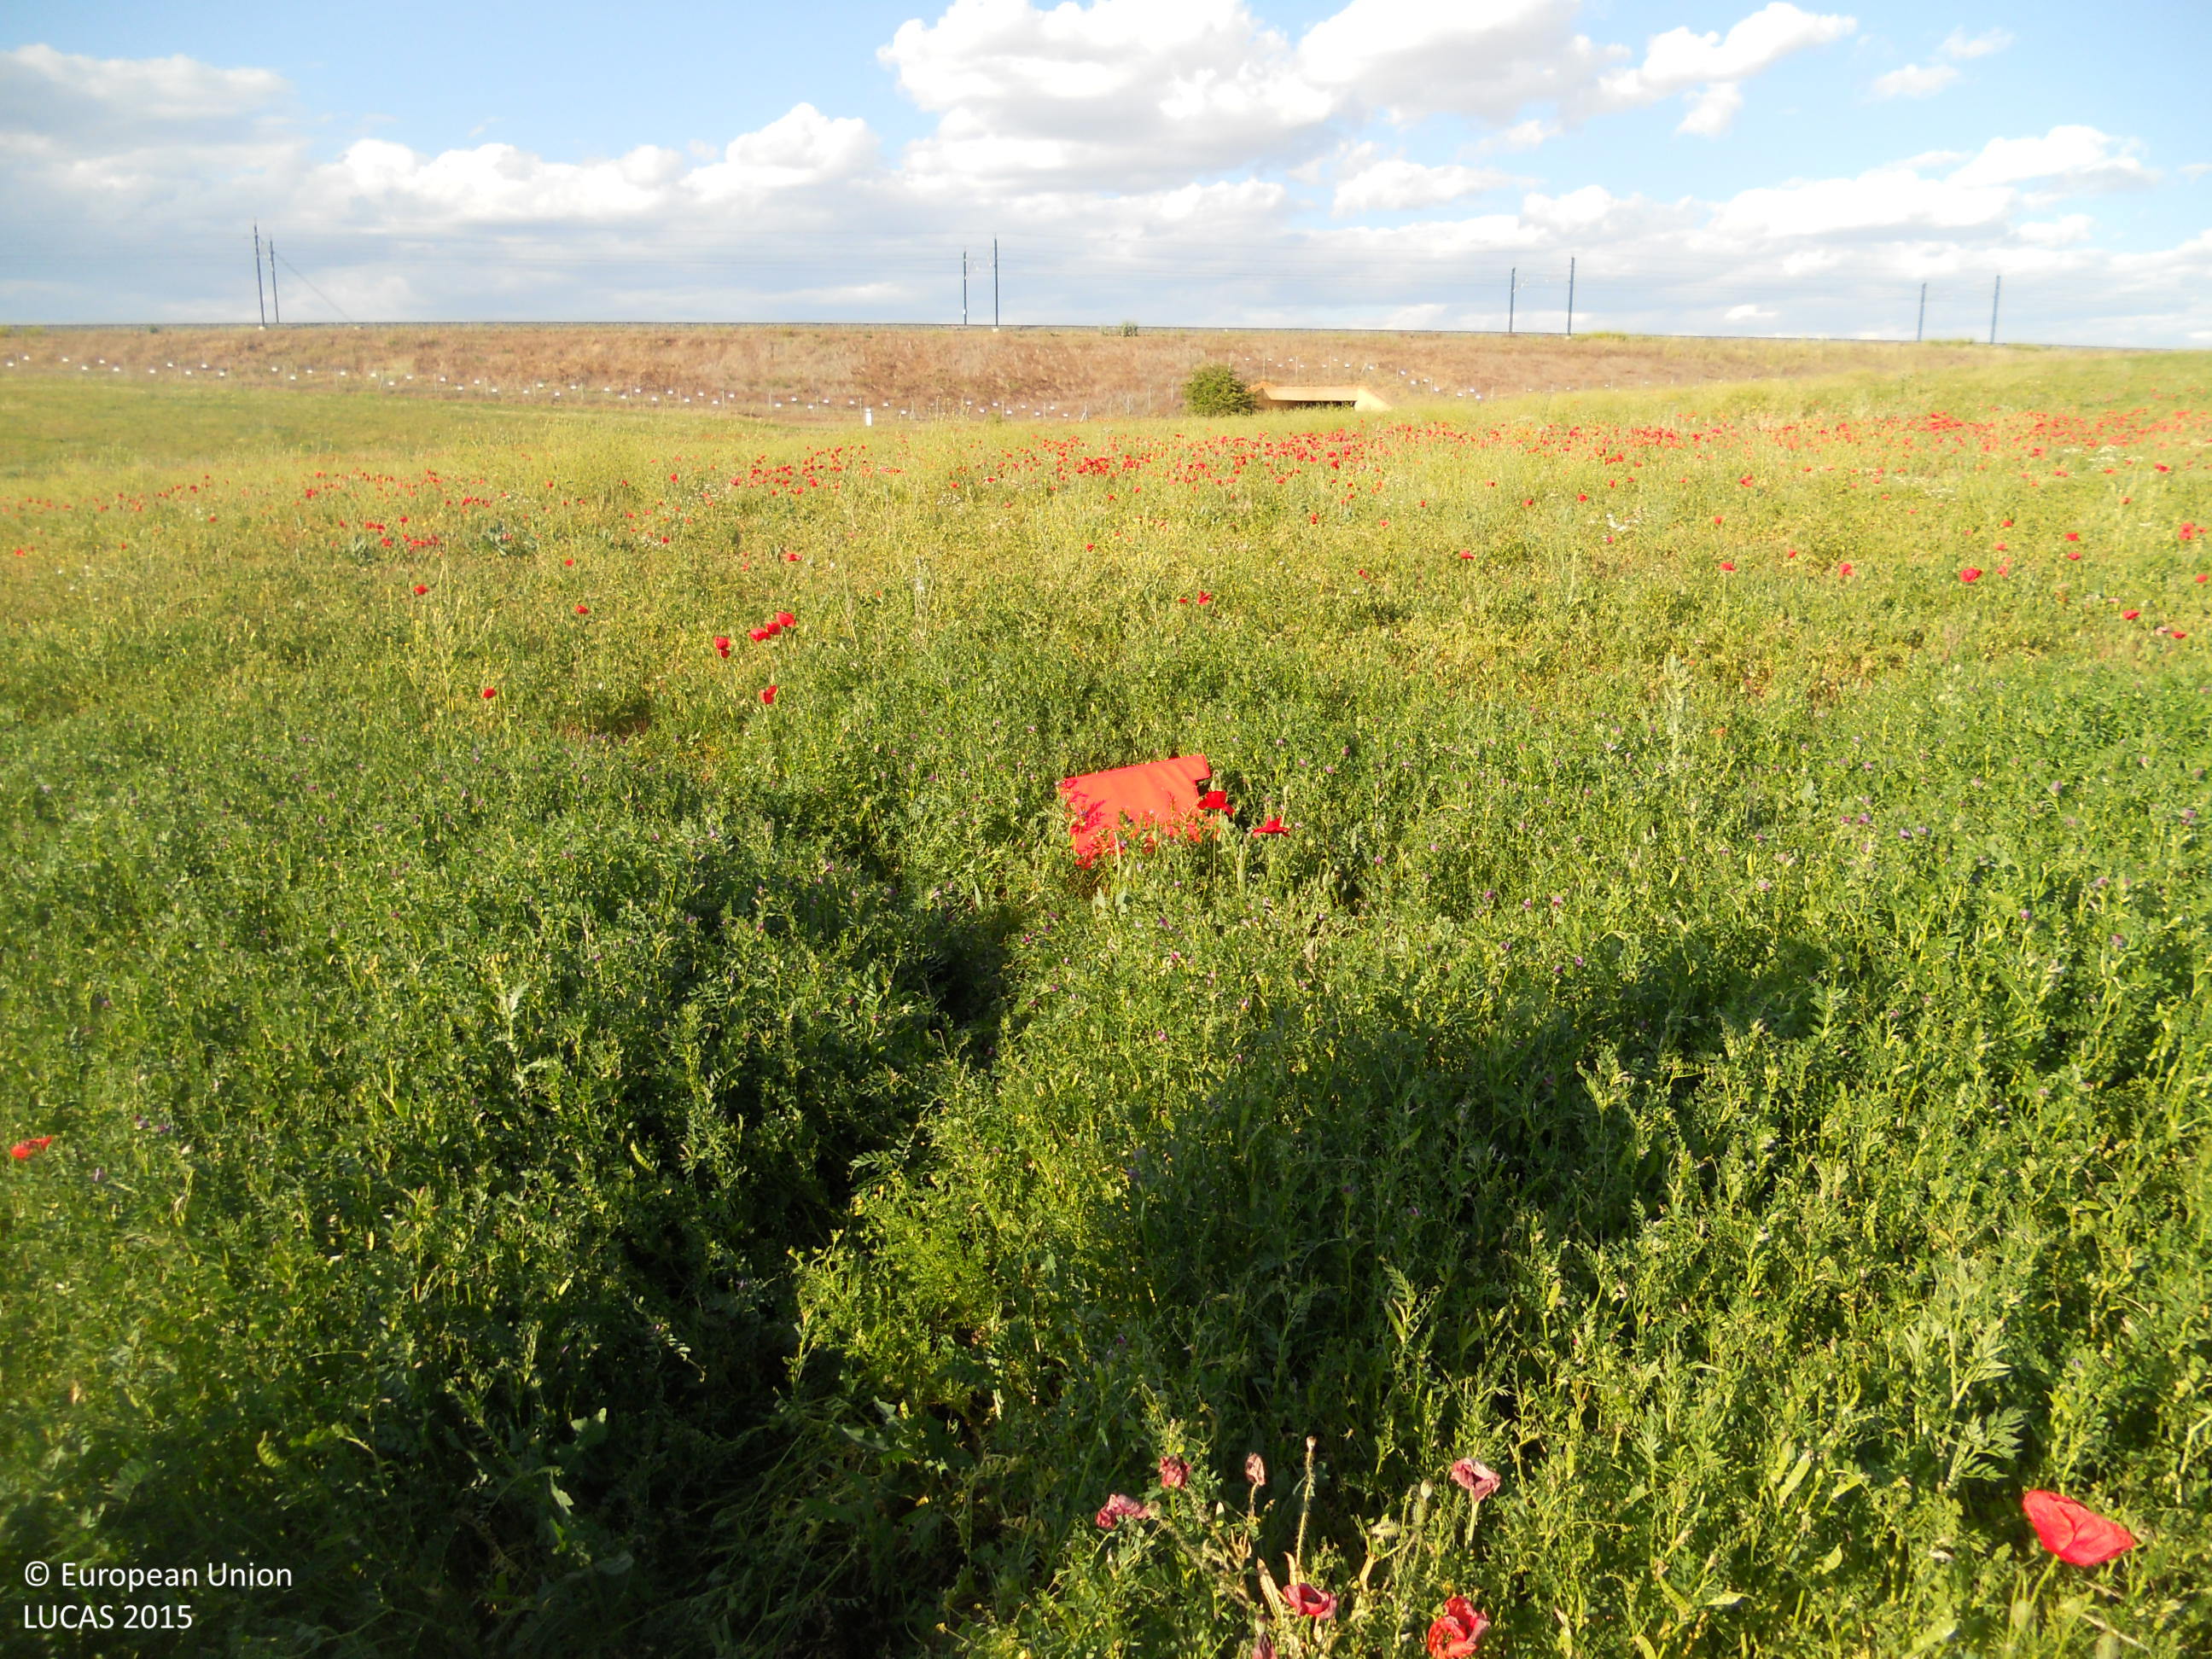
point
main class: Cropland
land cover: Dry pulses
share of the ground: > 75 %
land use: Agriculture (excluding fallow land and kitchen gardens)
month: May
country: ES
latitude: 42.2555
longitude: -4.9290
